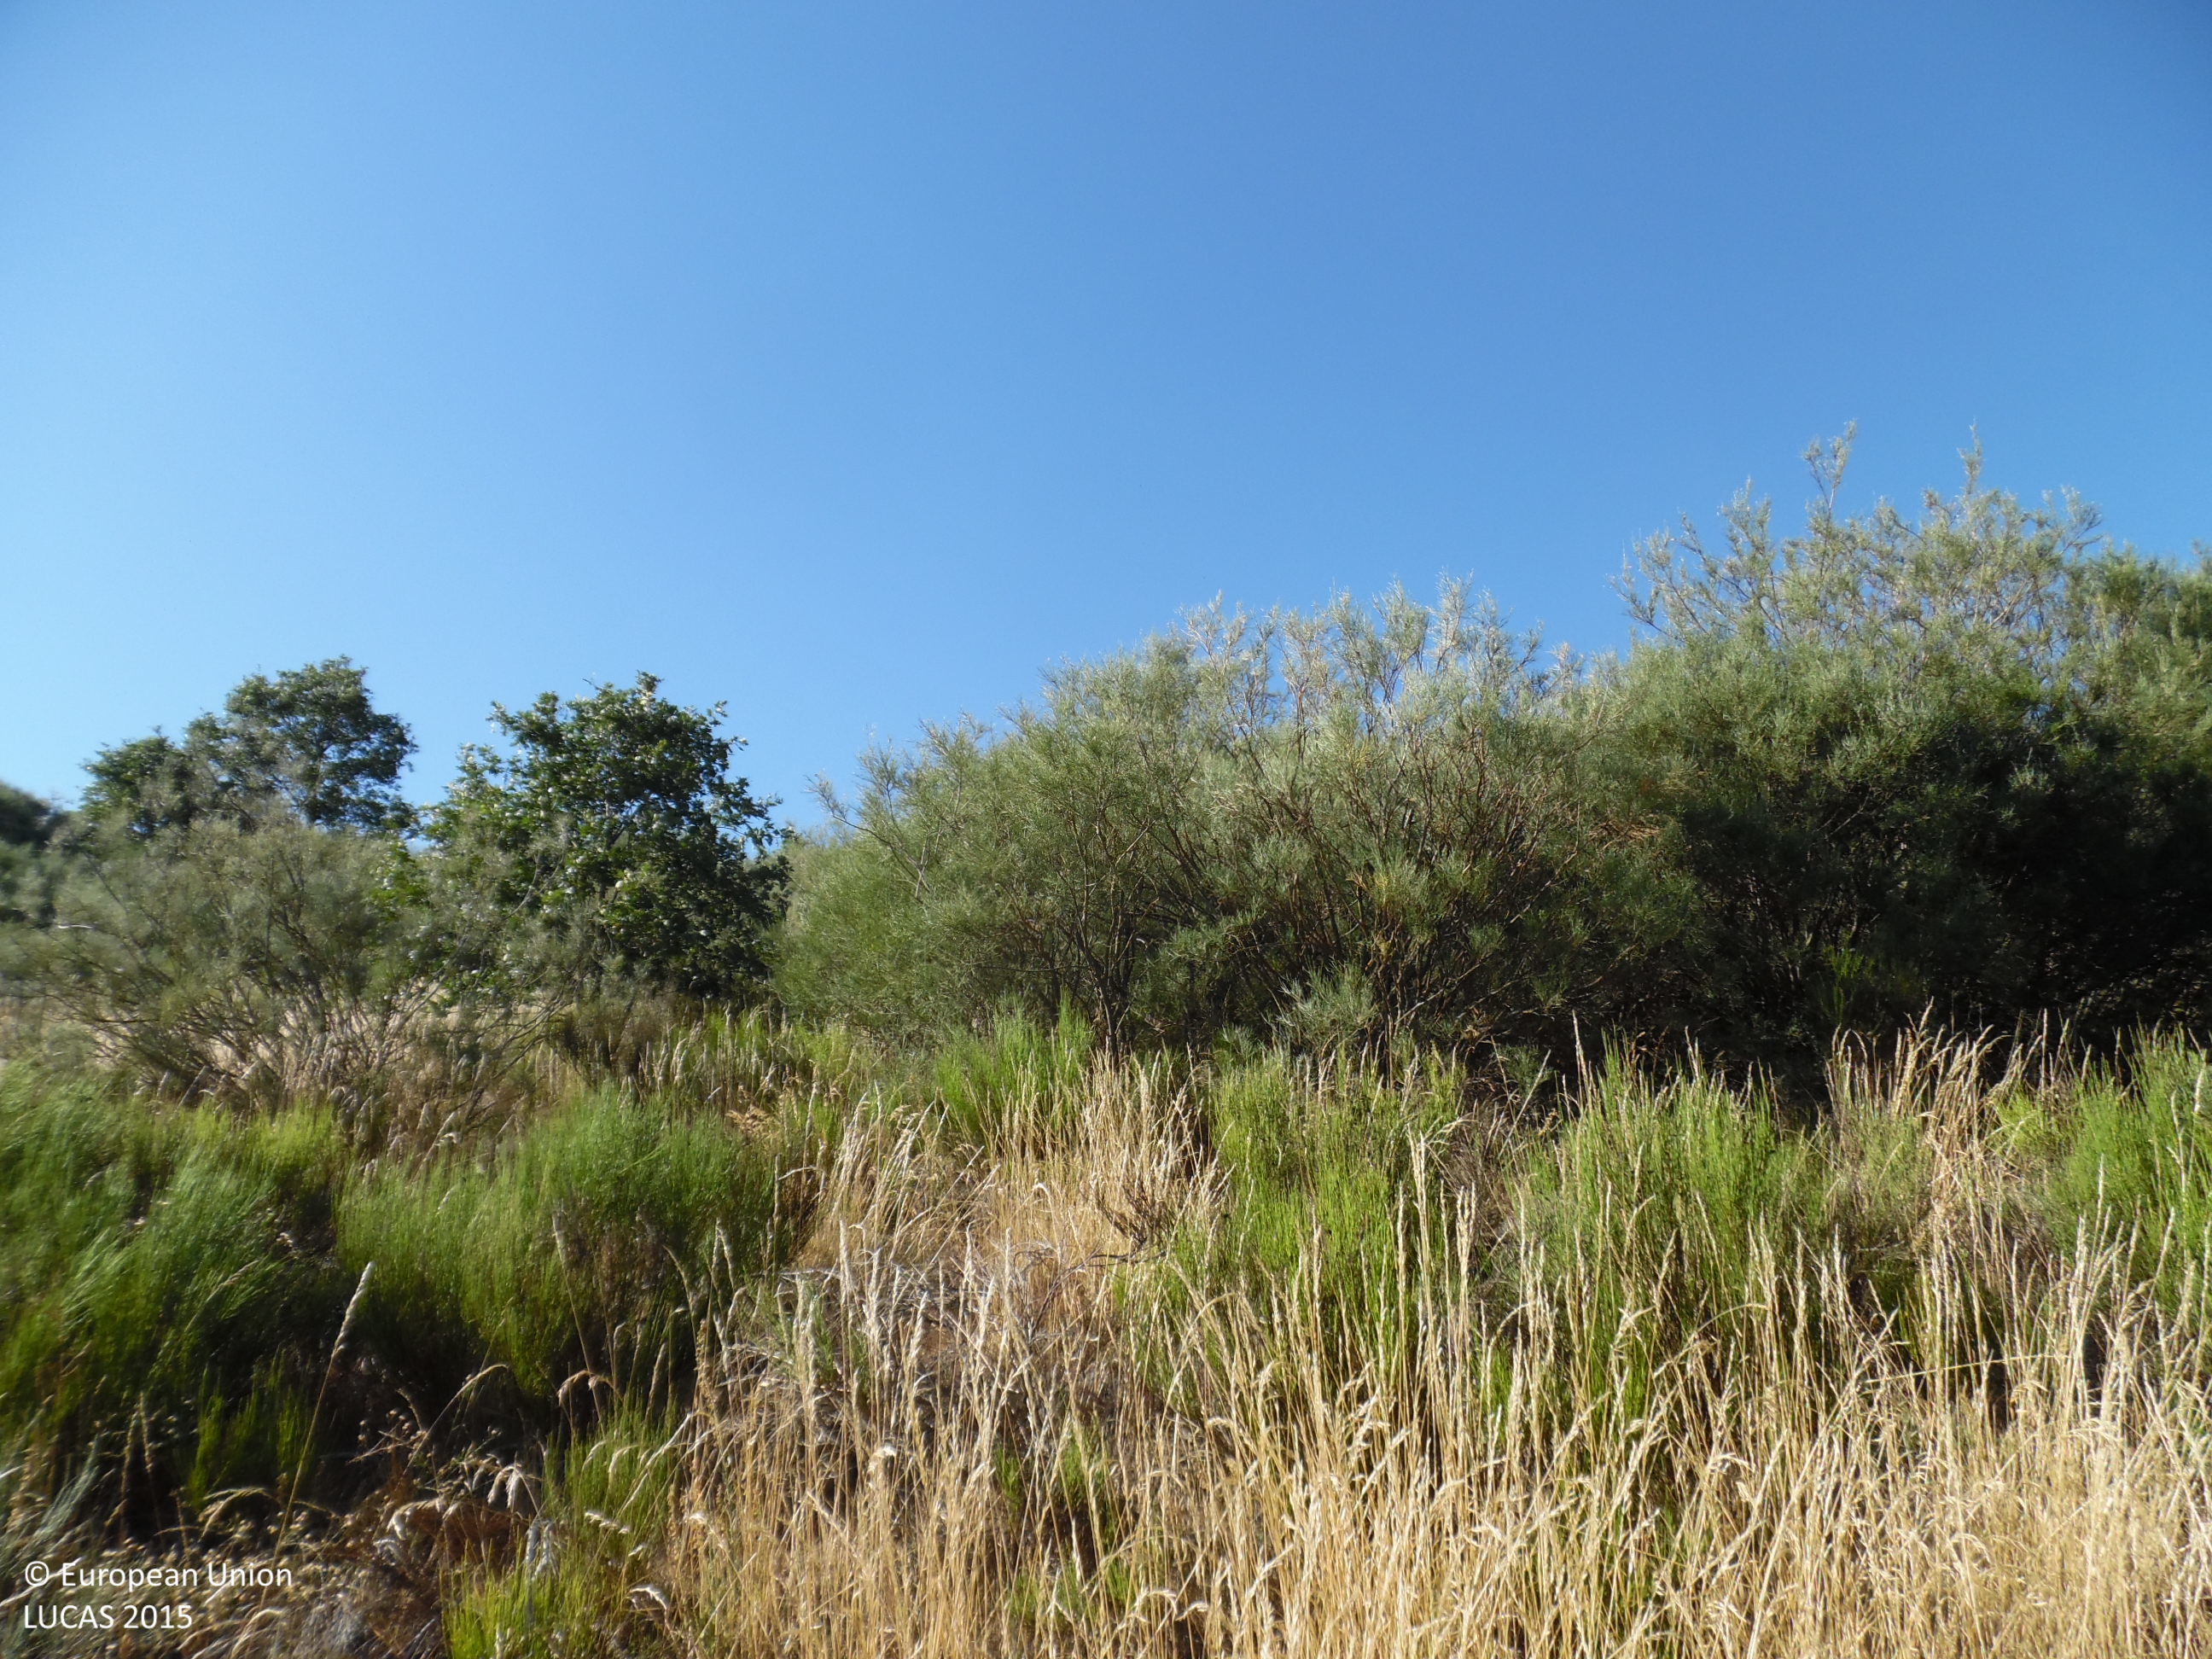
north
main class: Shrubland
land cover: Shrubland with sparse tree cover
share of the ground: > 75 %
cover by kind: shrubs 95 %, broadleaved forest trees 5 %
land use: Abandoned areas
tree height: > 5 m
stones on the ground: 10 - 25 %
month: August
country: ES
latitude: 42.7367
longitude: -6.1995
